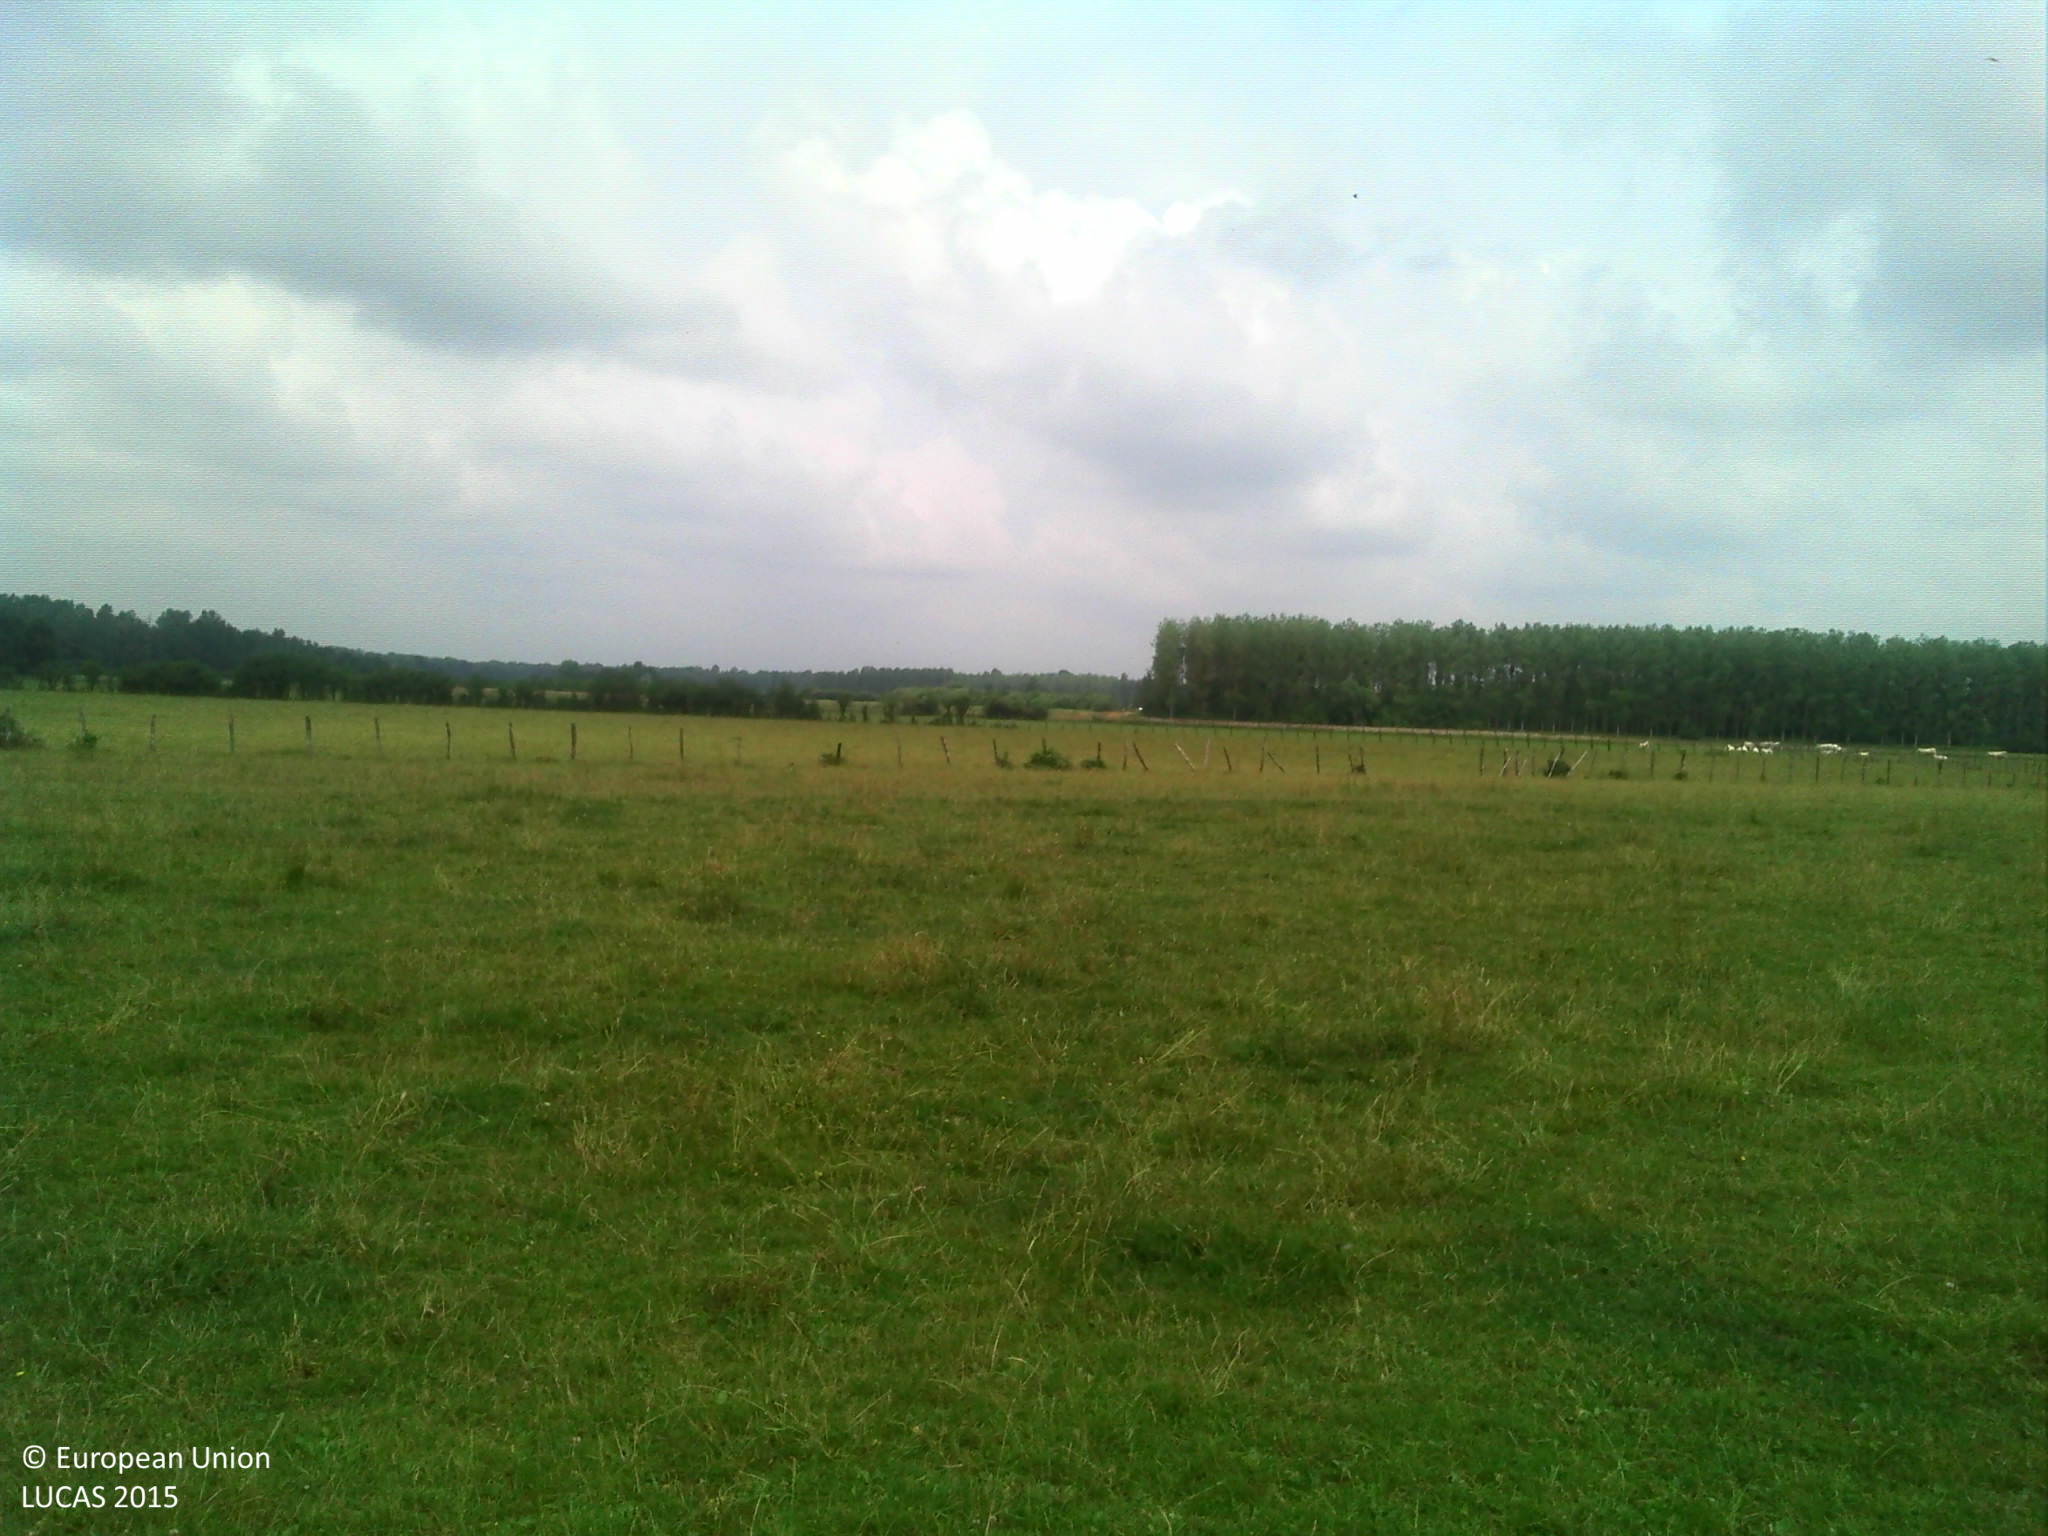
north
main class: Grassland
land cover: Grassland without tree/shrub cover
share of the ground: > 75 %
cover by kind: herbaceous plants 95 %, shrubs 5 %
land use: Agriculture (excluding fallow land and kitchen gardens)
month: June
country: FR
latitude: 47.2640
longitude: 5.4416
